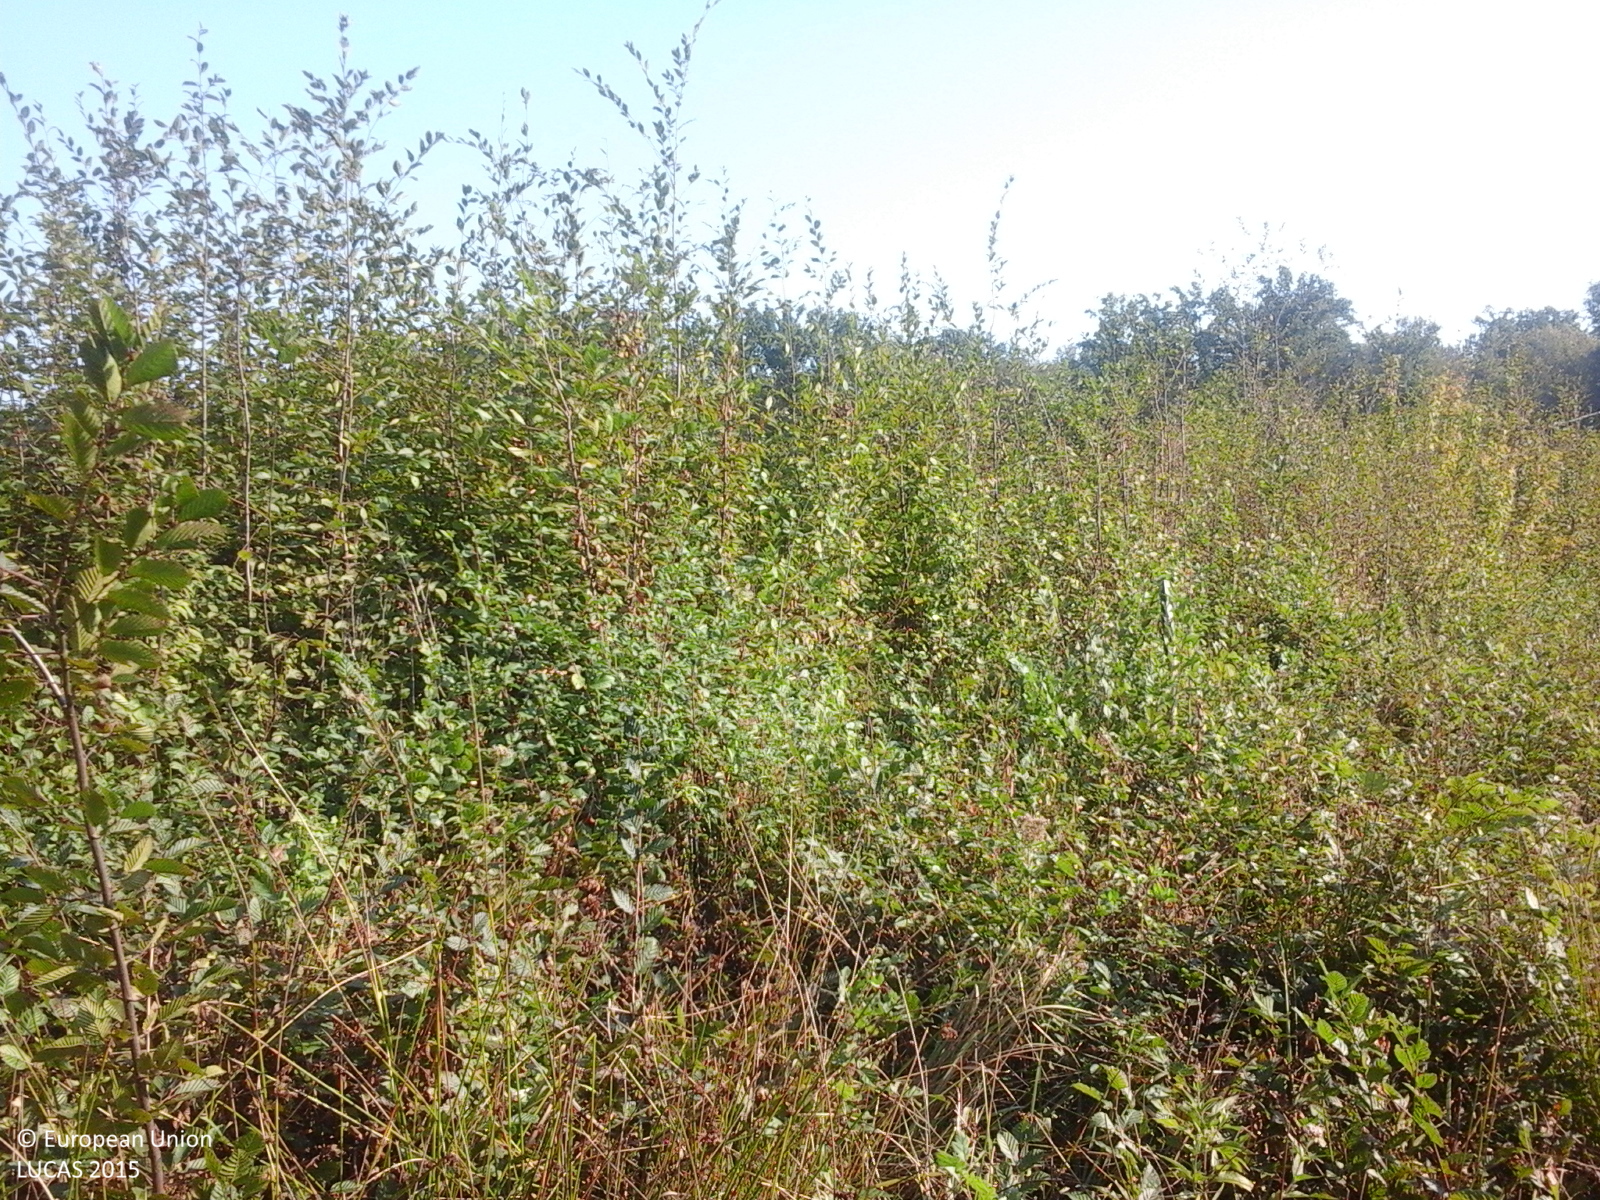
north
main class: Shrubland
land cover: Shrubland with sparse tree cover
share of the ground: > 75 %
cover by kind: herbaceous plants 75 %, shrubs 20 %, broadleaved forest trees 5 %
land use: Forestry
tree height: < 5 m
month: August
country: RO
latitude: 46.4192
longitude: 22.1593
